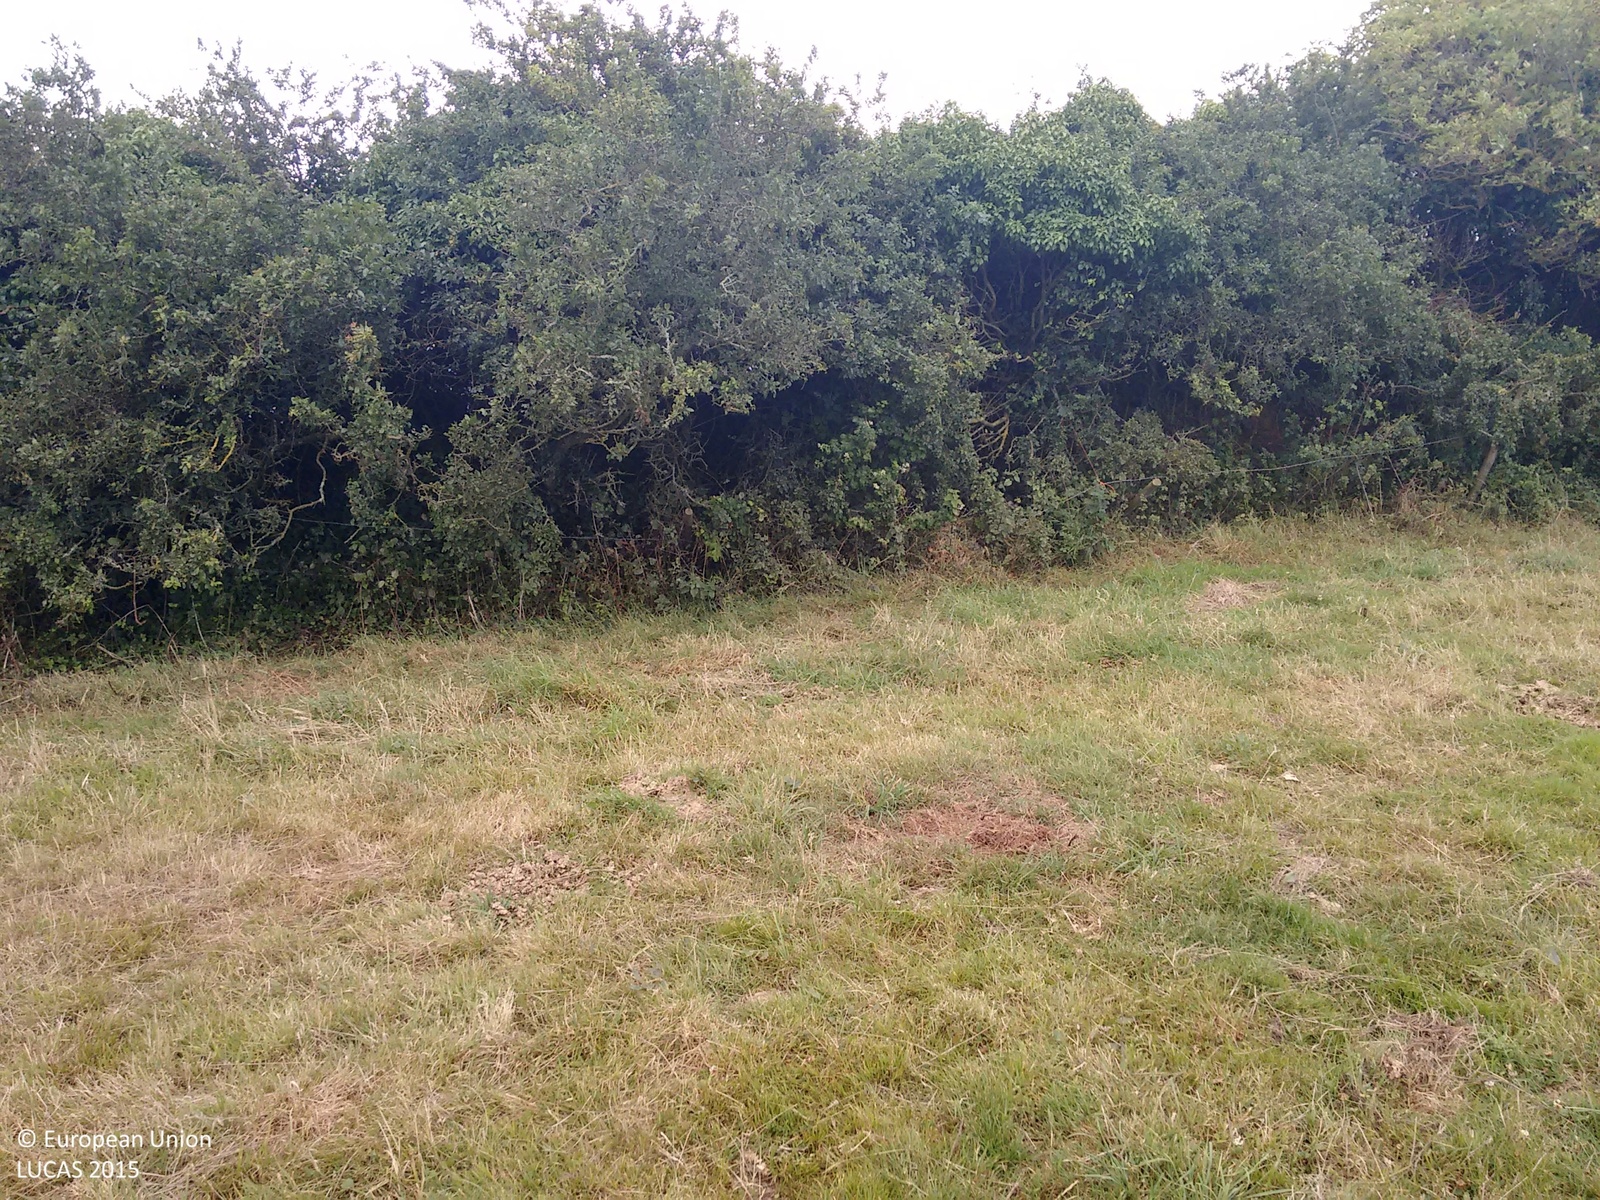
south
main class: Grassland
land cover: Grassland without tree/shrub cover
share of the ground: > 75 %
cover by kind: herbaceous plants 85 %, unconsolidated bare surface 15 %
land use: Agriculture (excluding fallow land and kitchen gardens)
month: July
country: GB
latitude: 50.3781
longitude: -3.5130
